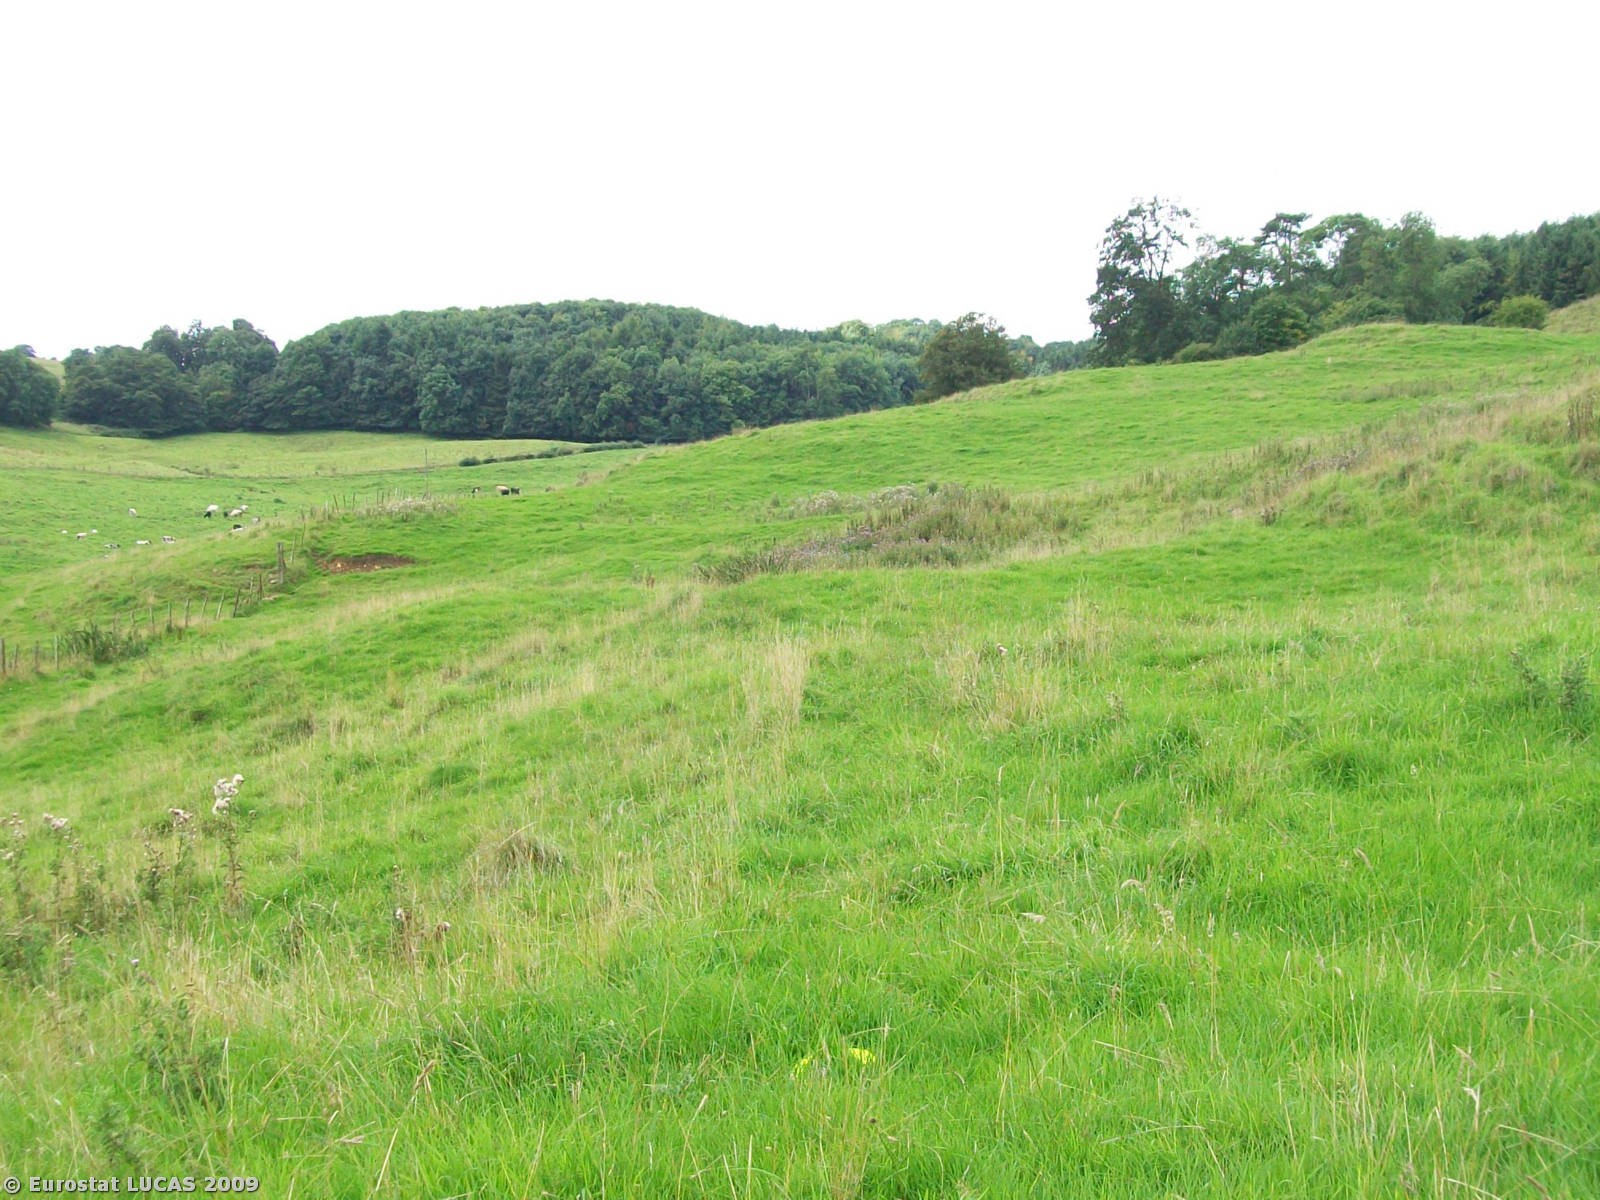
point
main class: Grassland
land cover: Grassland without tree/shrub cover
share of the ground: > 75 %
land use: Agriculture (excluding fallow land and kitchen gardens)
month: August
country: GB
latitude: 51.6672
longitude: -2.2510
